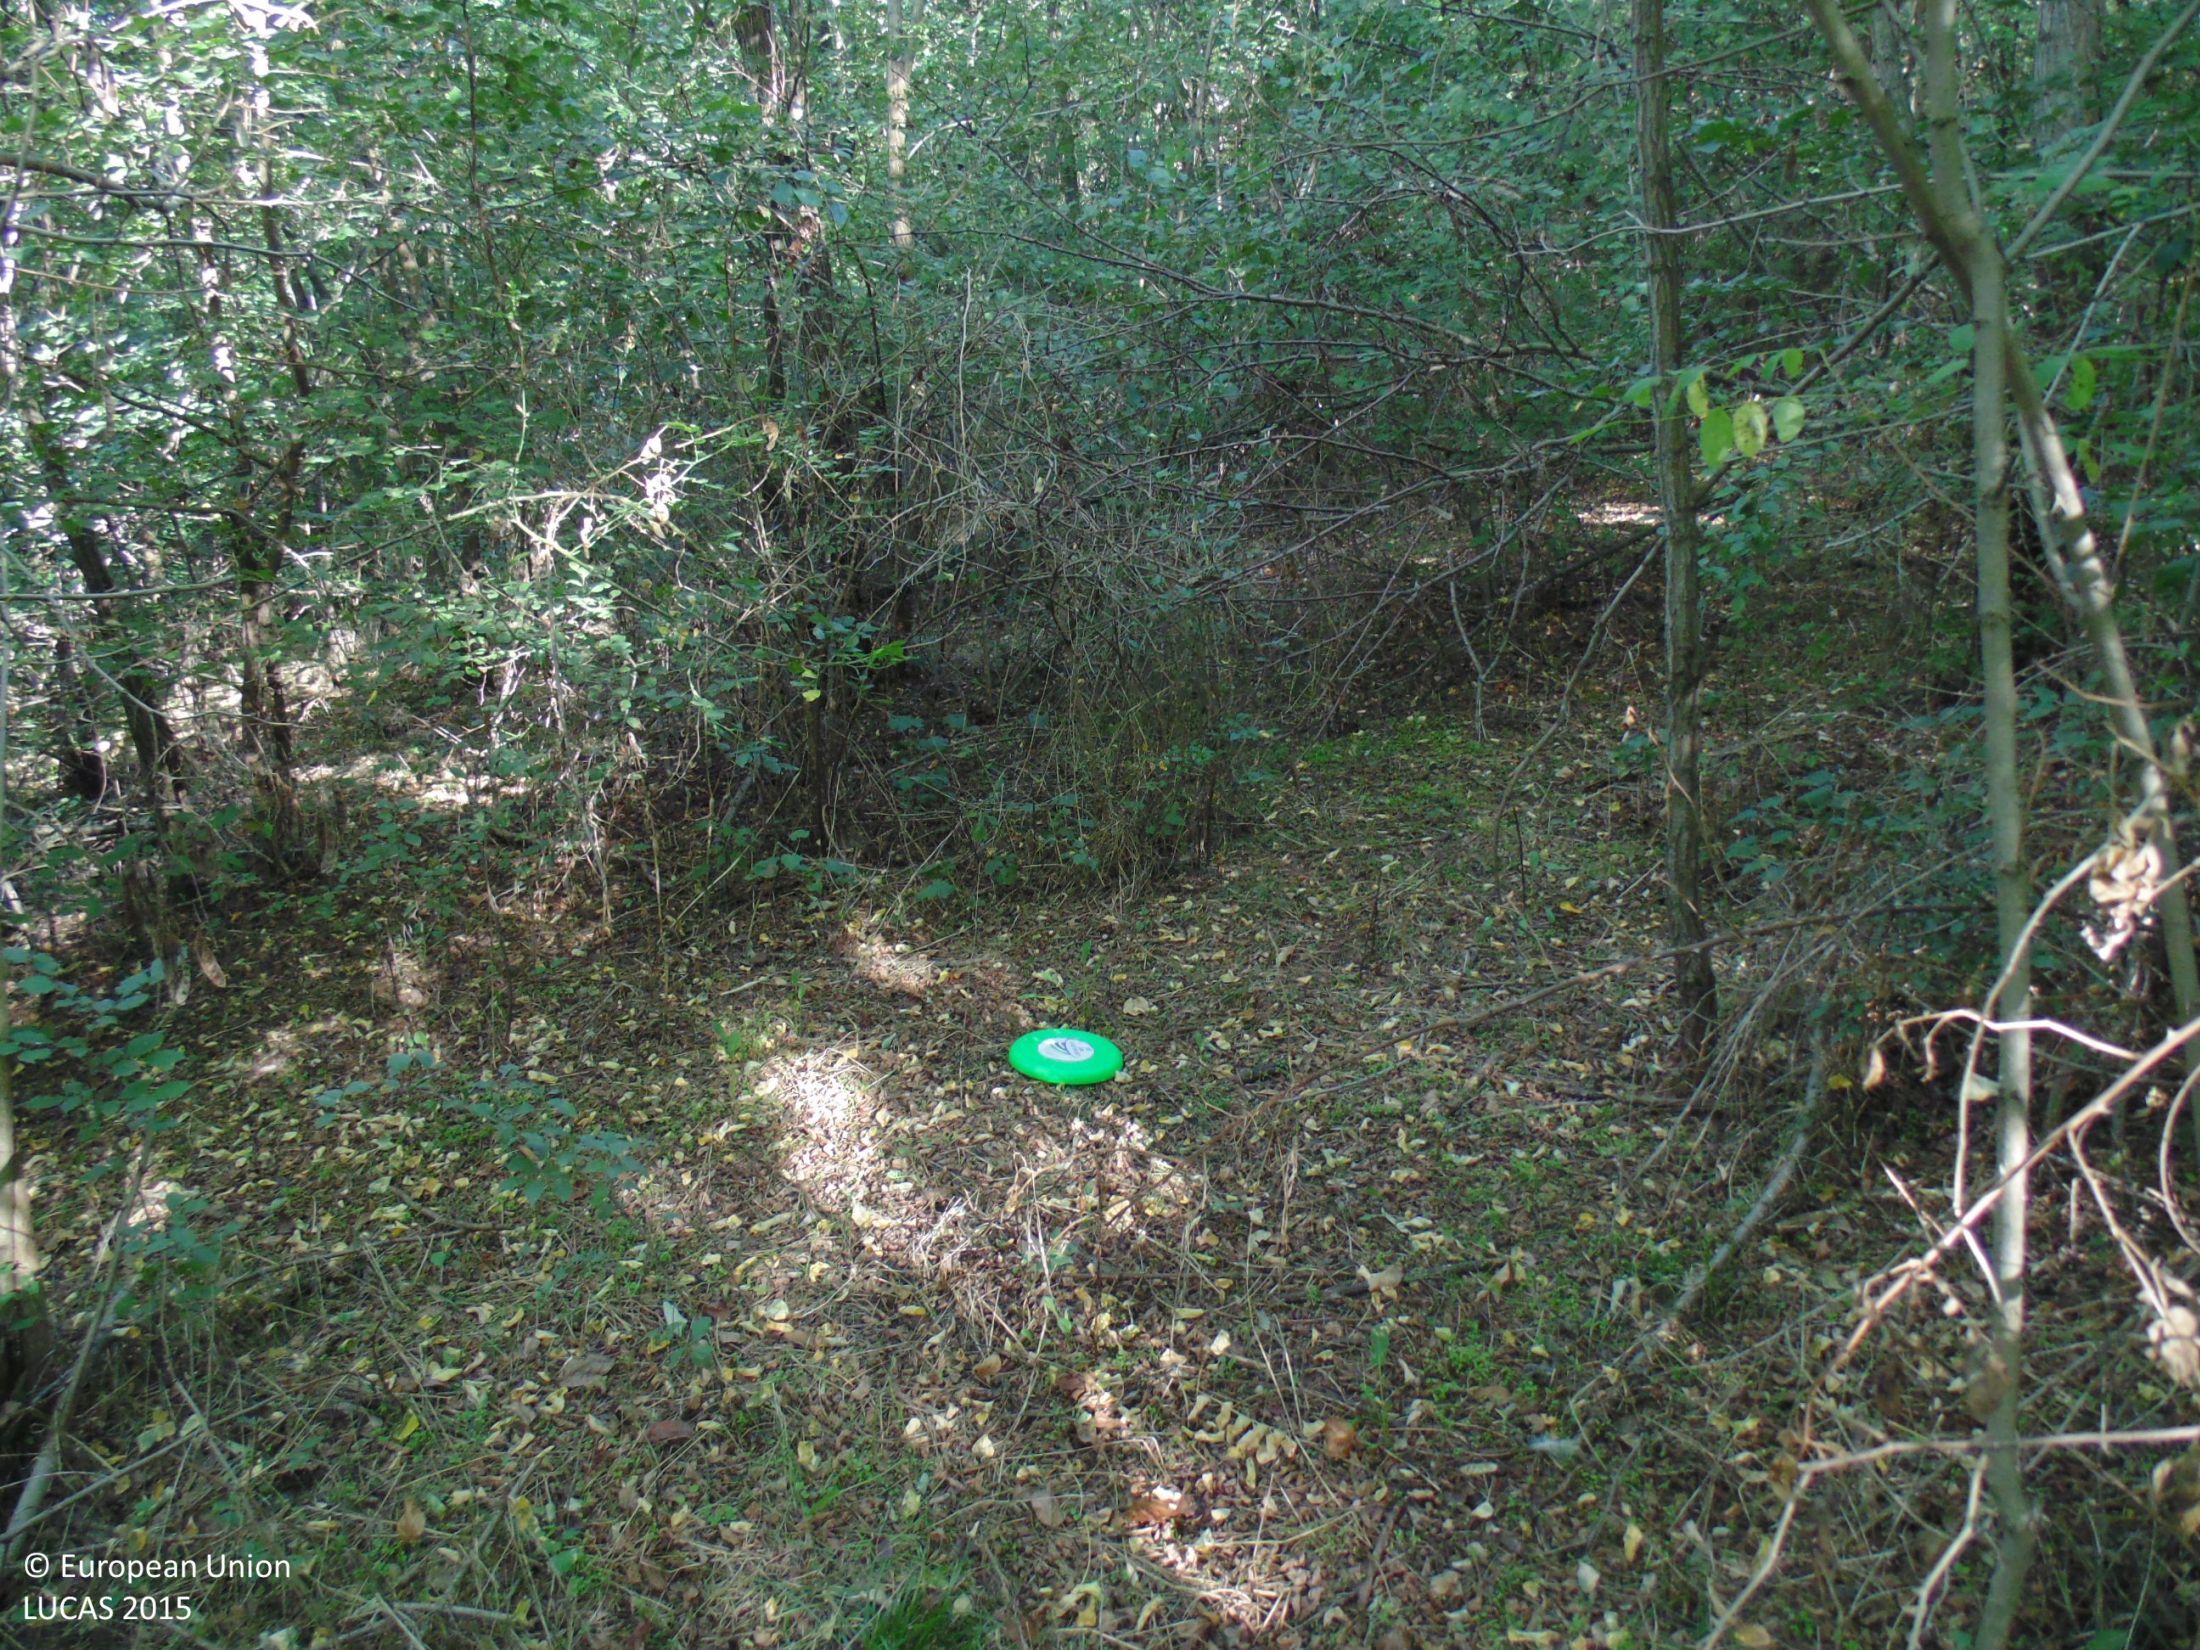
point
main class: Woodland
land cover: Broadleaved woodland
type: mesophytic deciduous forest
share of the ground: > 75 %
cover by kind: broadleaved forest trees 90 %, shrubs 5 %, unconsolidated bare surface 5 %
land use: Forestry
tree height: > 5 m
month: September
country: BG
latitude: 43.8384
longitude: 27.1009
